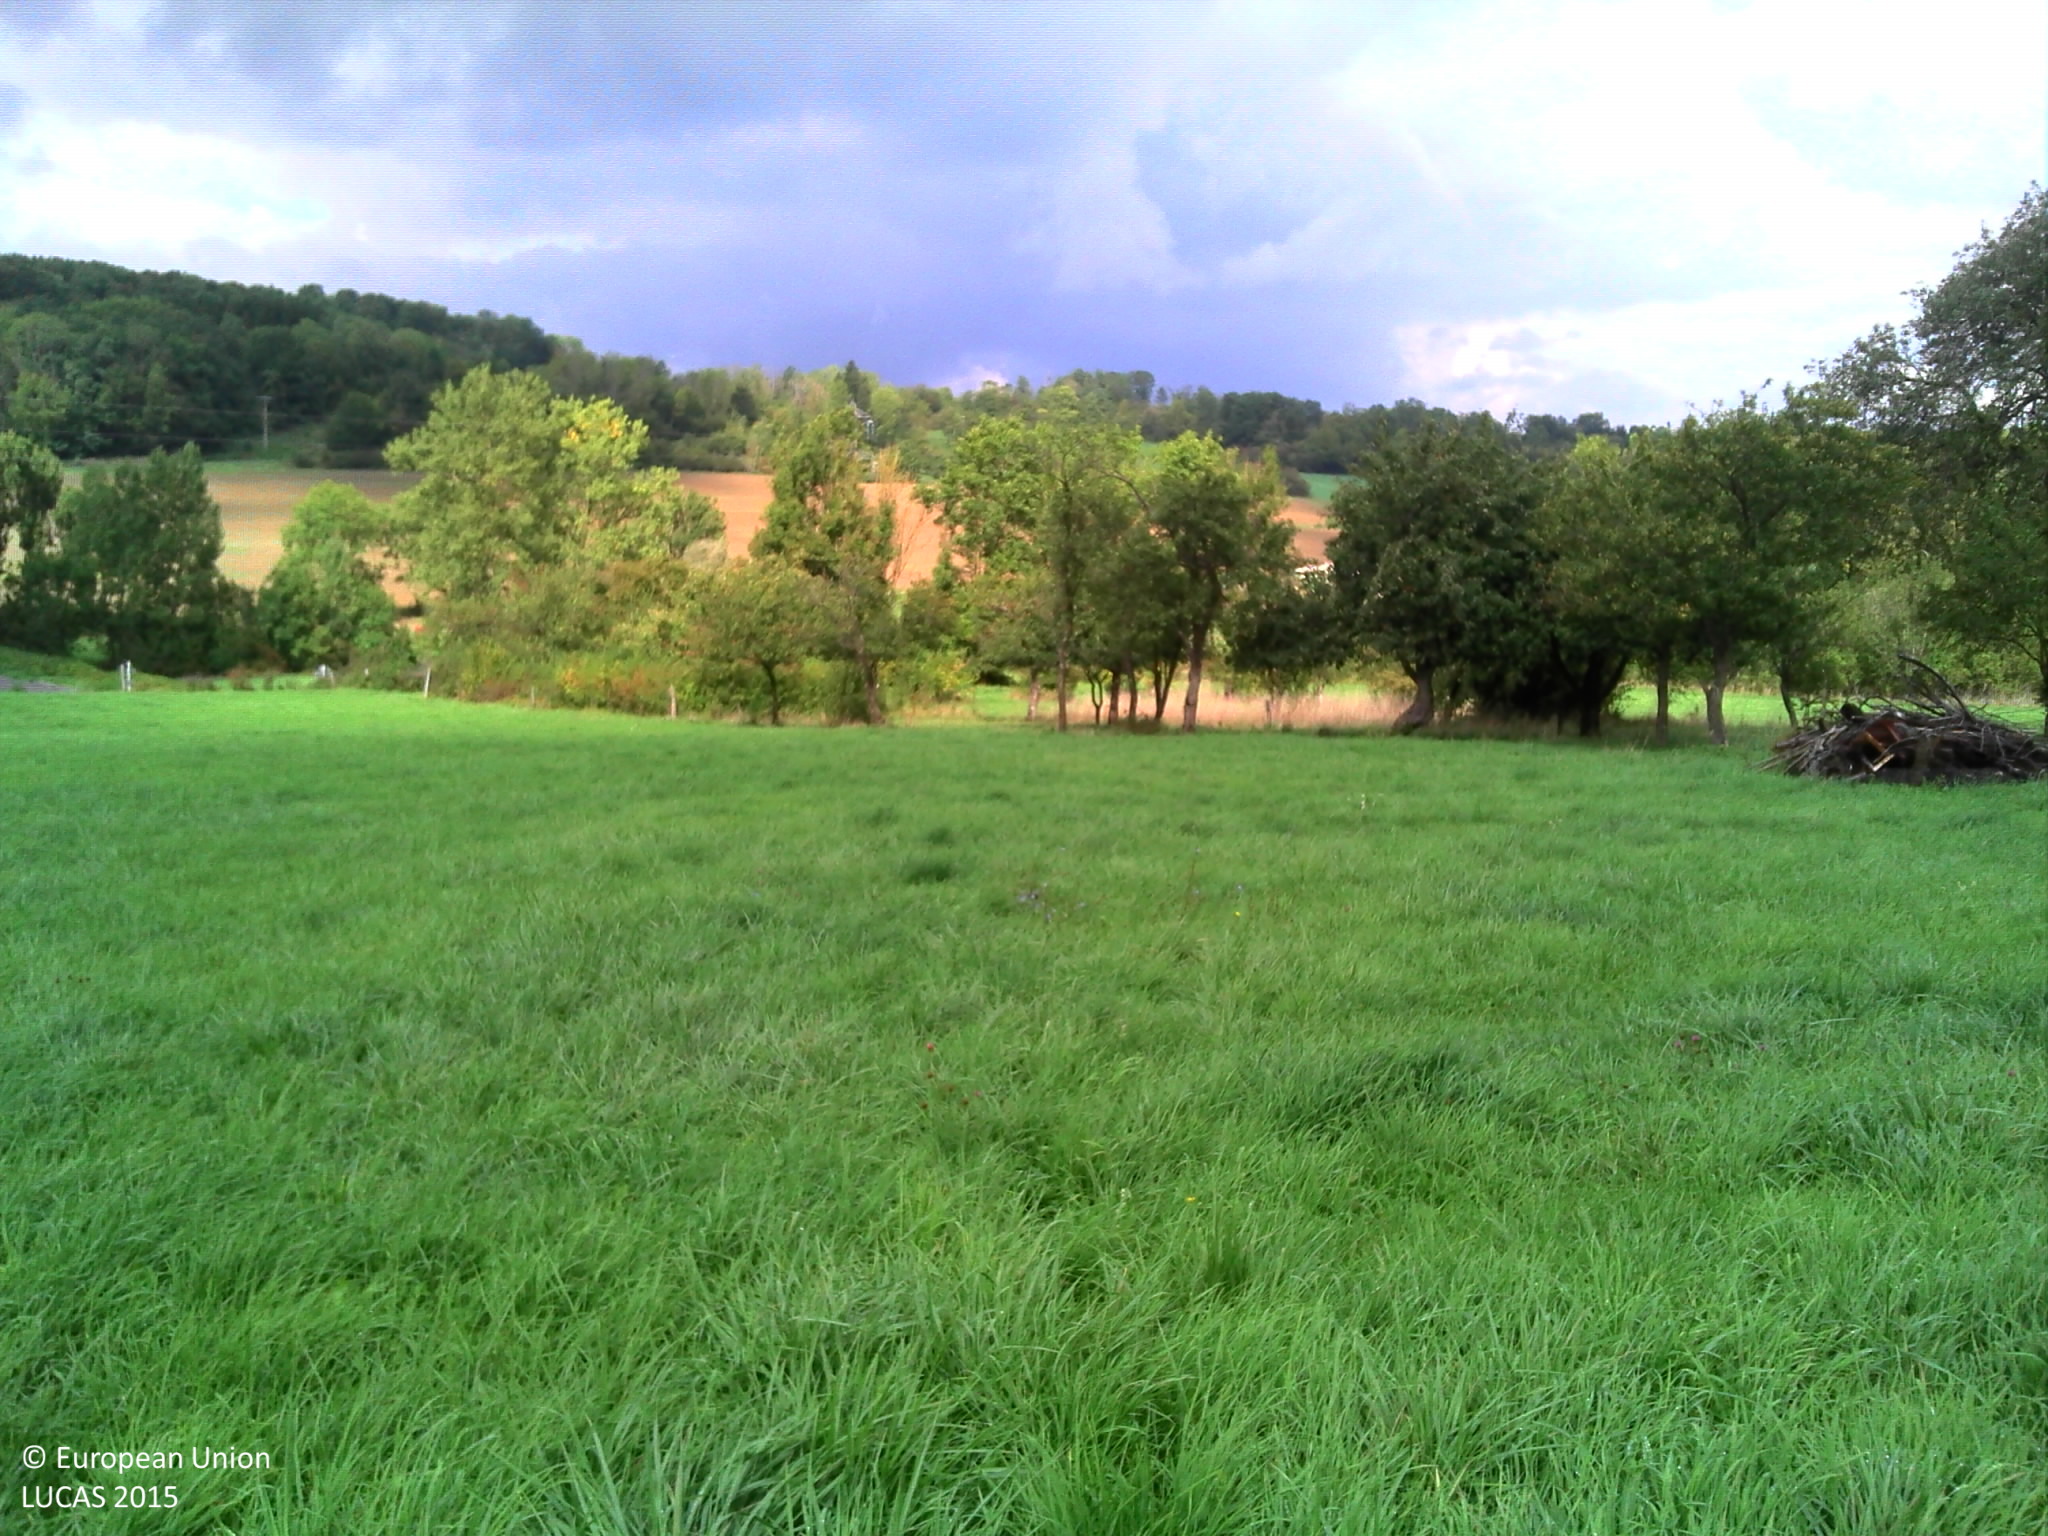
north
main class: Grassland
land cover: Grassland without tree/shrub cover
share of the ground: > 75 %
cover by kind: herbaceous plants 95 %, consolidated bare surface 5 %
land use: Agriculture (excluding fallow land and kitchen gardens)
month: September
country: FR
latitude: 48.5745
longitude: 6.8426
